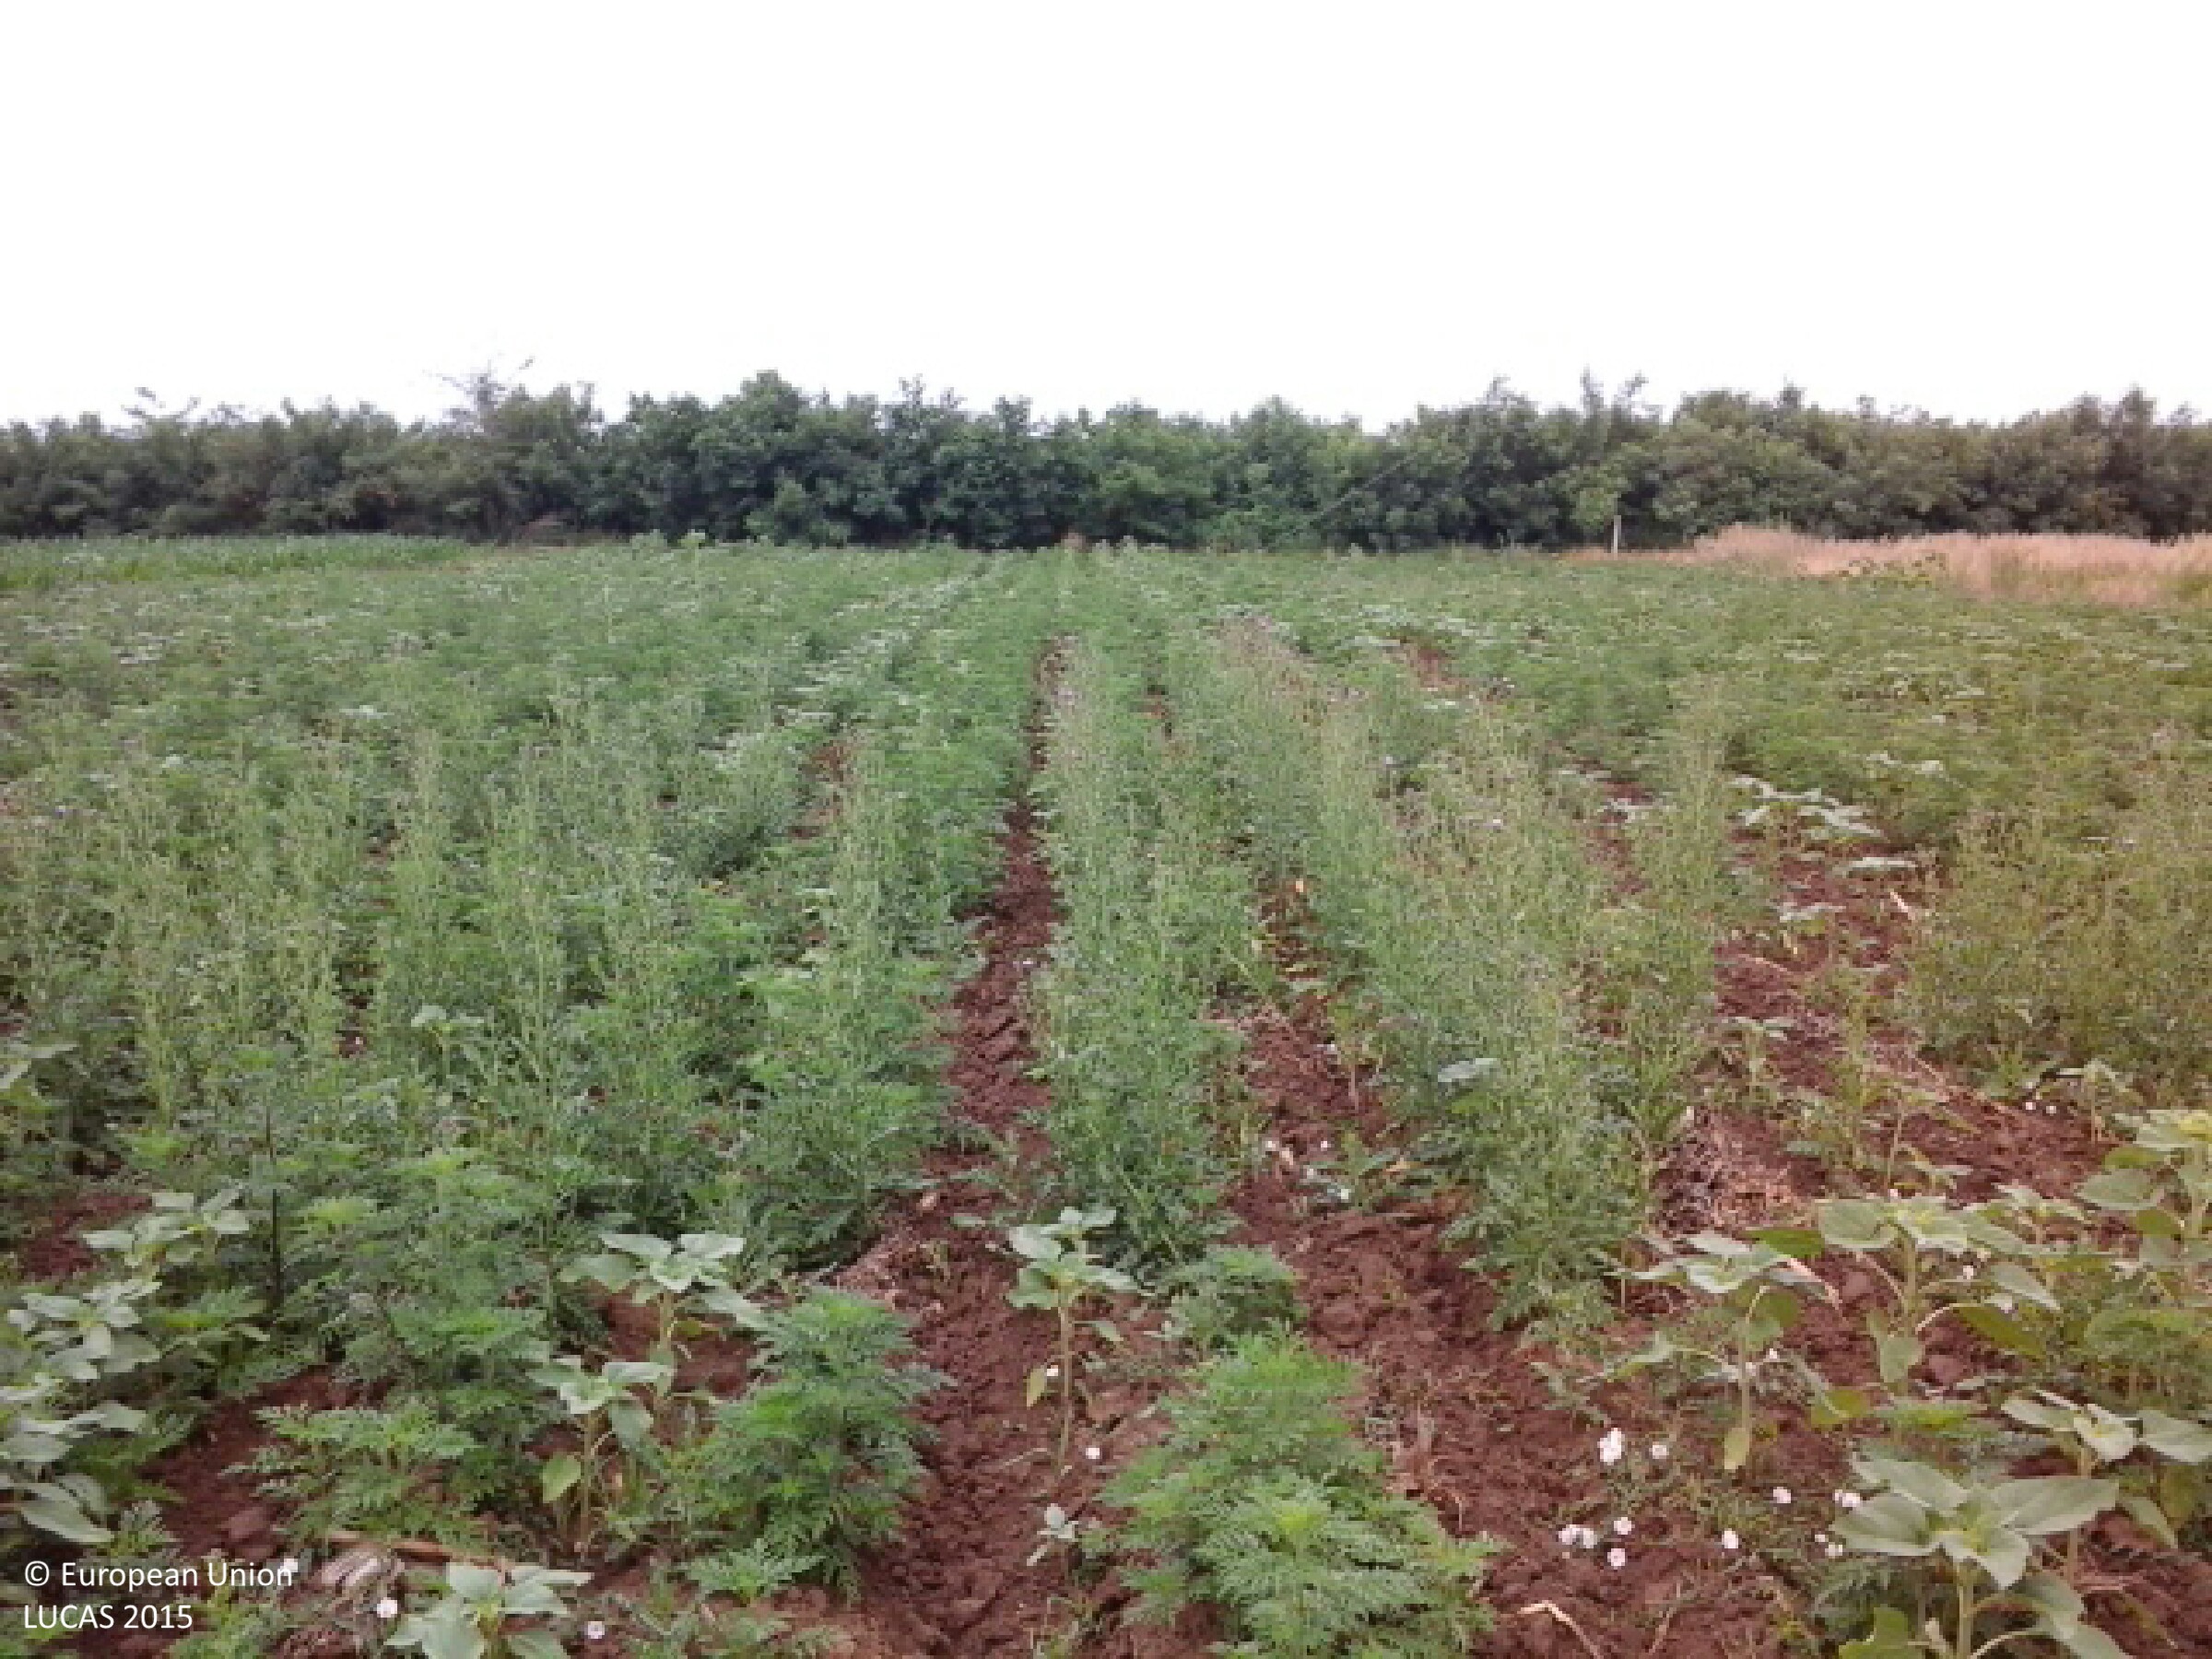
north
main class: Cropland
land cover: Sunflower
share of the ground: 10 - 25 %
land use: Agriculture (excluding fallow land and kitchen gardens)
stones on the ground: < 10 %
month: June
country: HU
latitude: 47.9547
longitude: 21.7655
